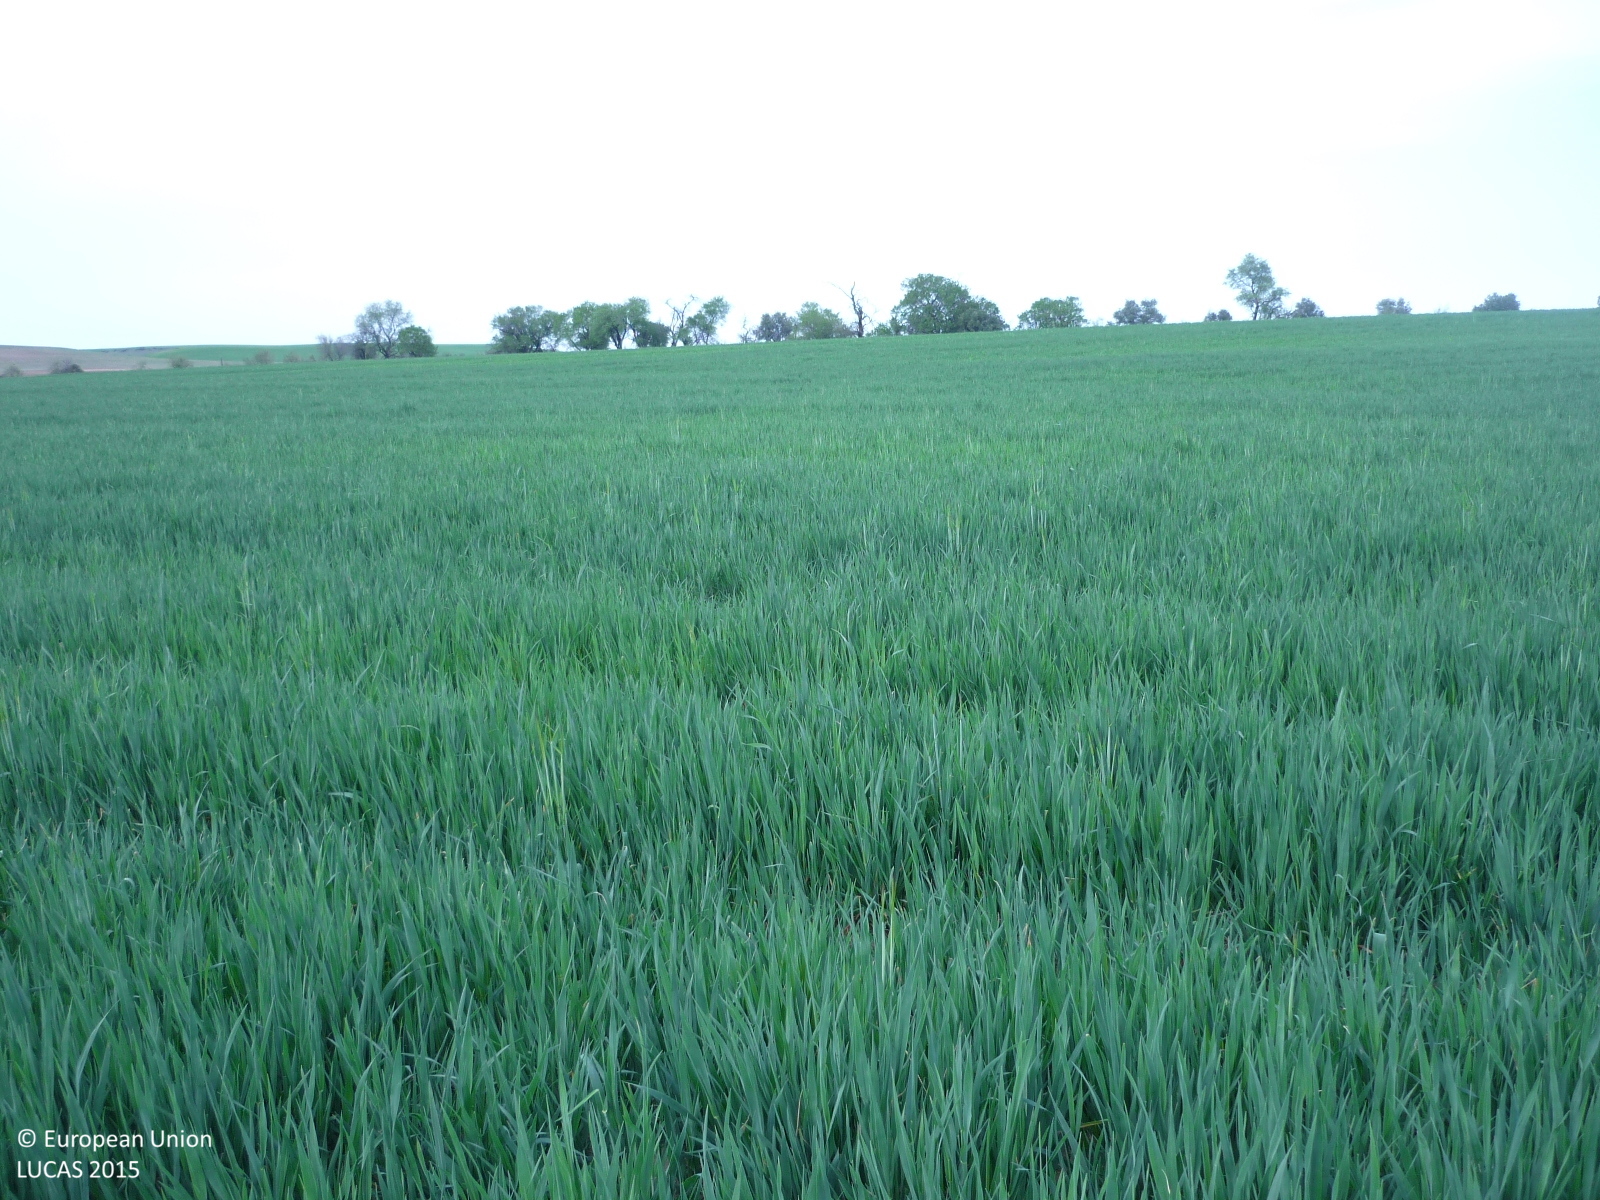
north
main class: Cropland
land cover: Rye
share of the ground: > 75 %
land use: Agriculture (excluding fallow land and kitchen gardens)
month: April
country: ES
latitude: 40.5854
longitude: -3.4221
